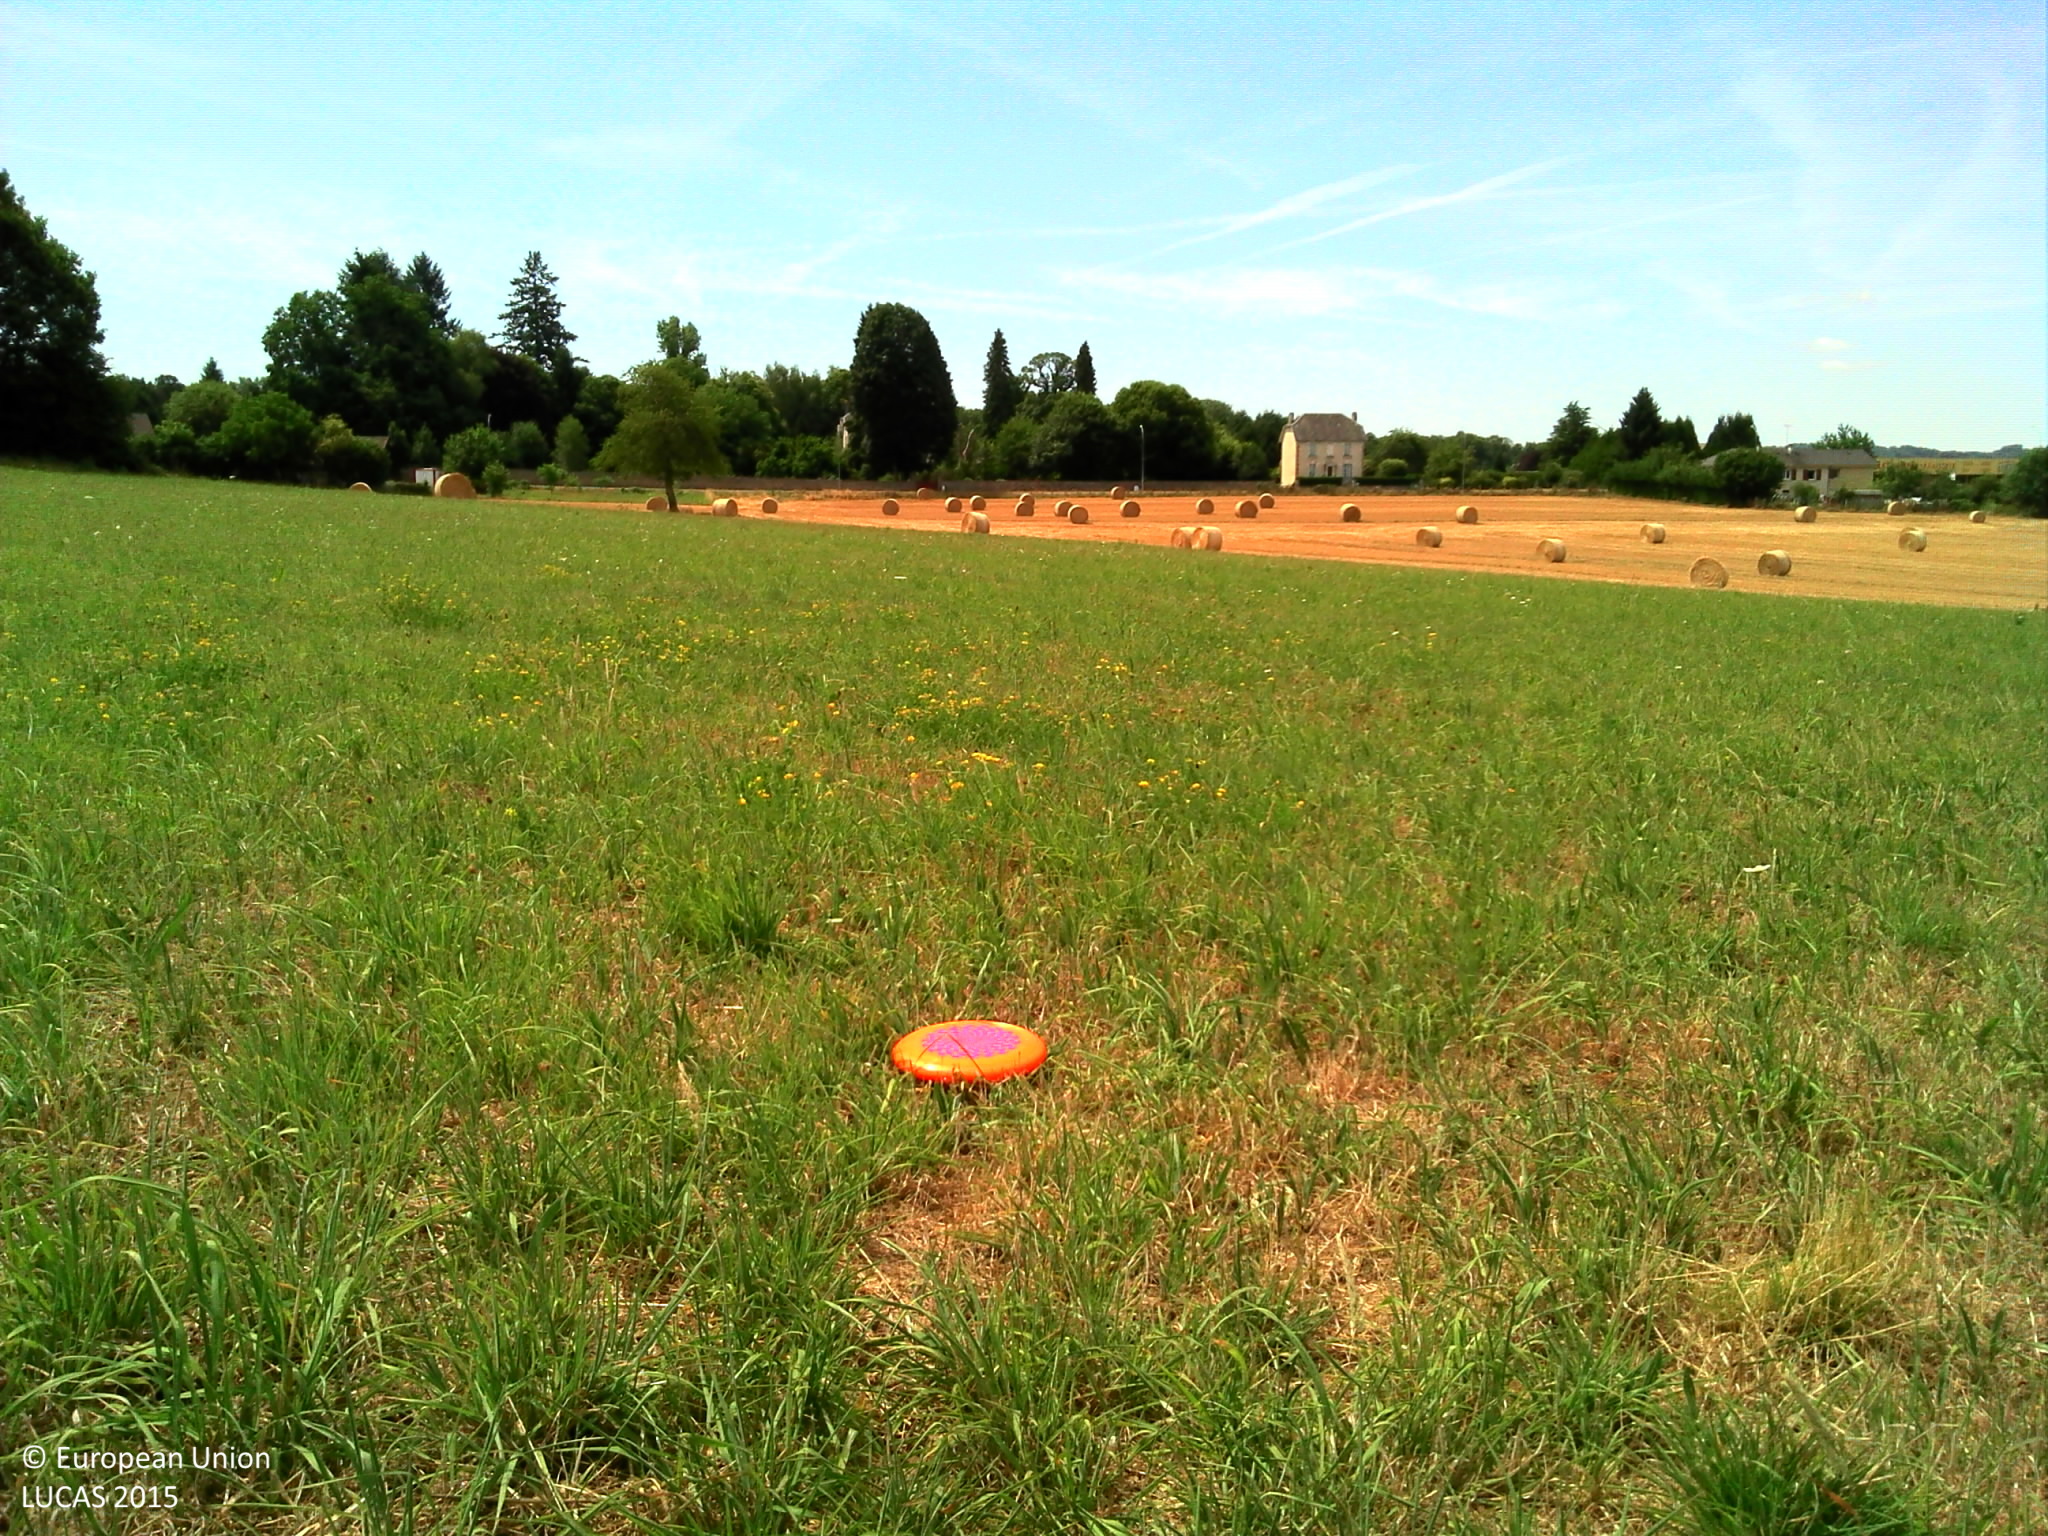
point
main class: Cropland
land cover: Temporary grasslands
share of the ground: > 75 %
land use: Agriculture (excluding fallow land and kitchen gardens)
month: July
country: FR
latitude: 45.7328
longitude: 1.6276
